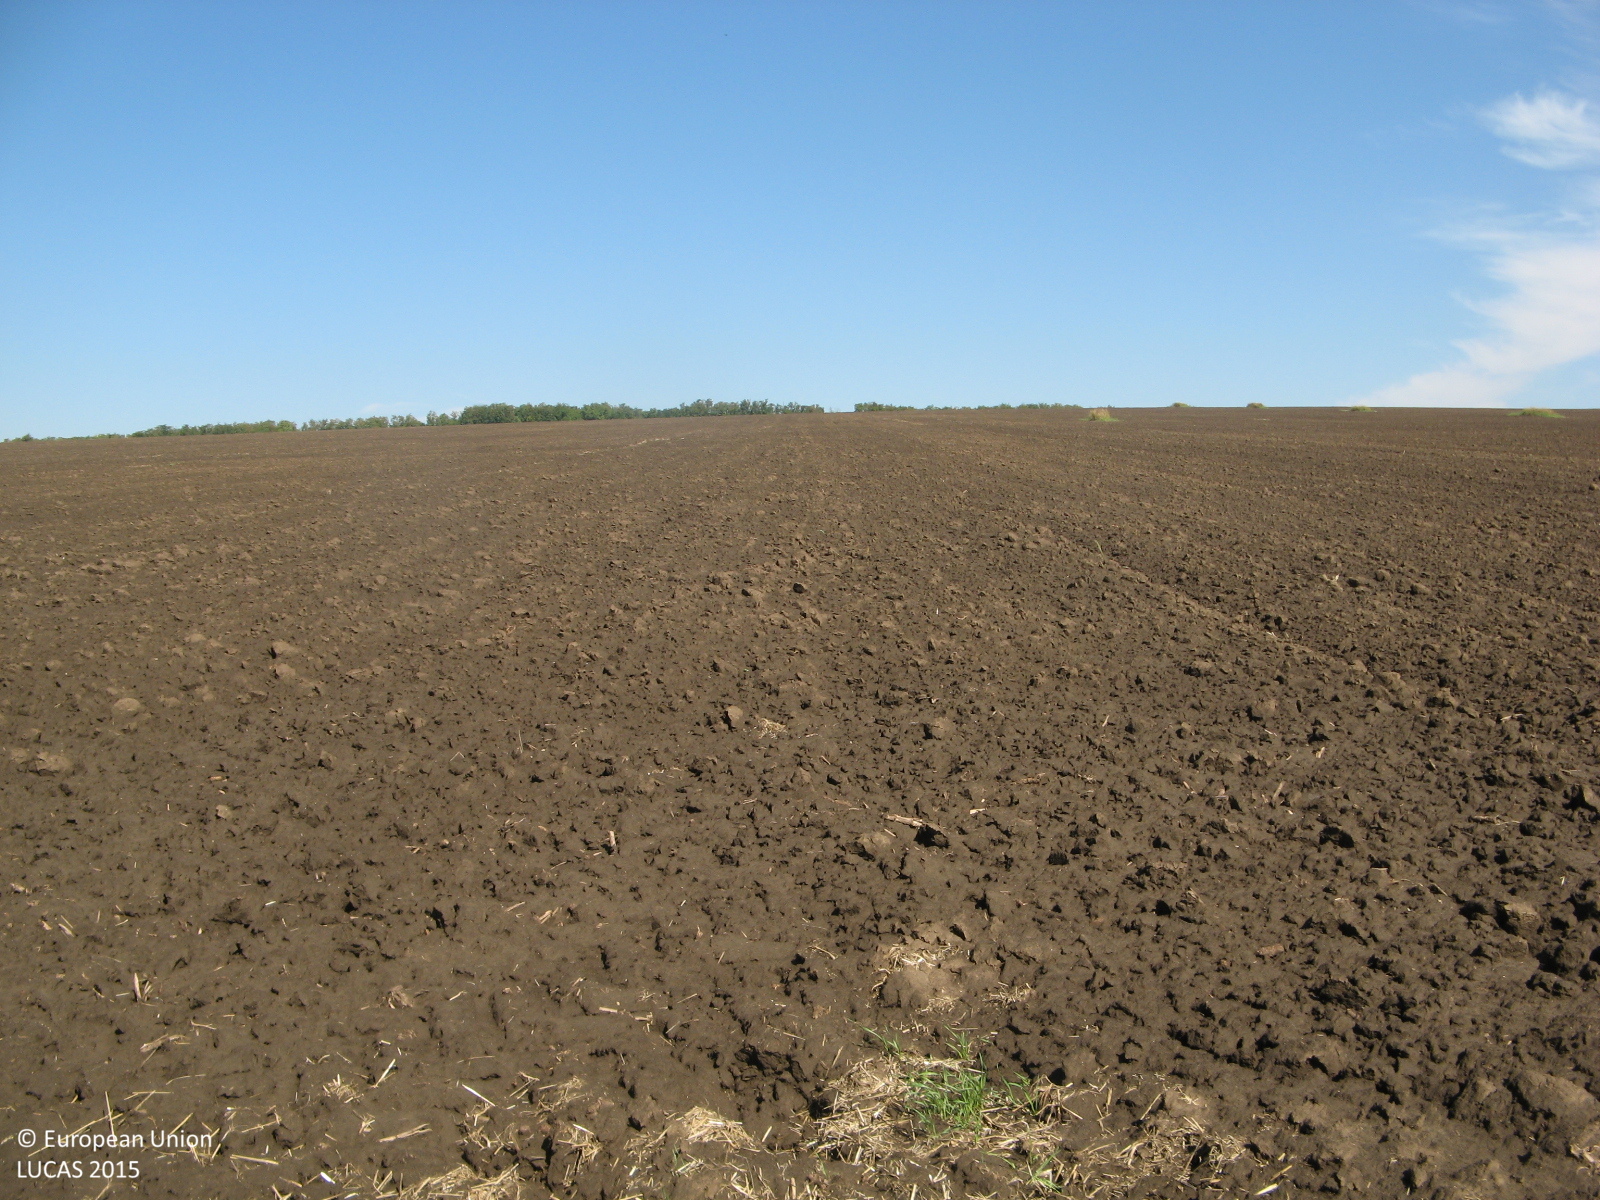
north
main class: Cropland
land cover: Common wheat
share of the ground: < 10 %
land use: Agriculture (excluding fallow land and kitchen gardens)
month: September
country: BG
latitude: 43.4408
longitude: 25.3364
